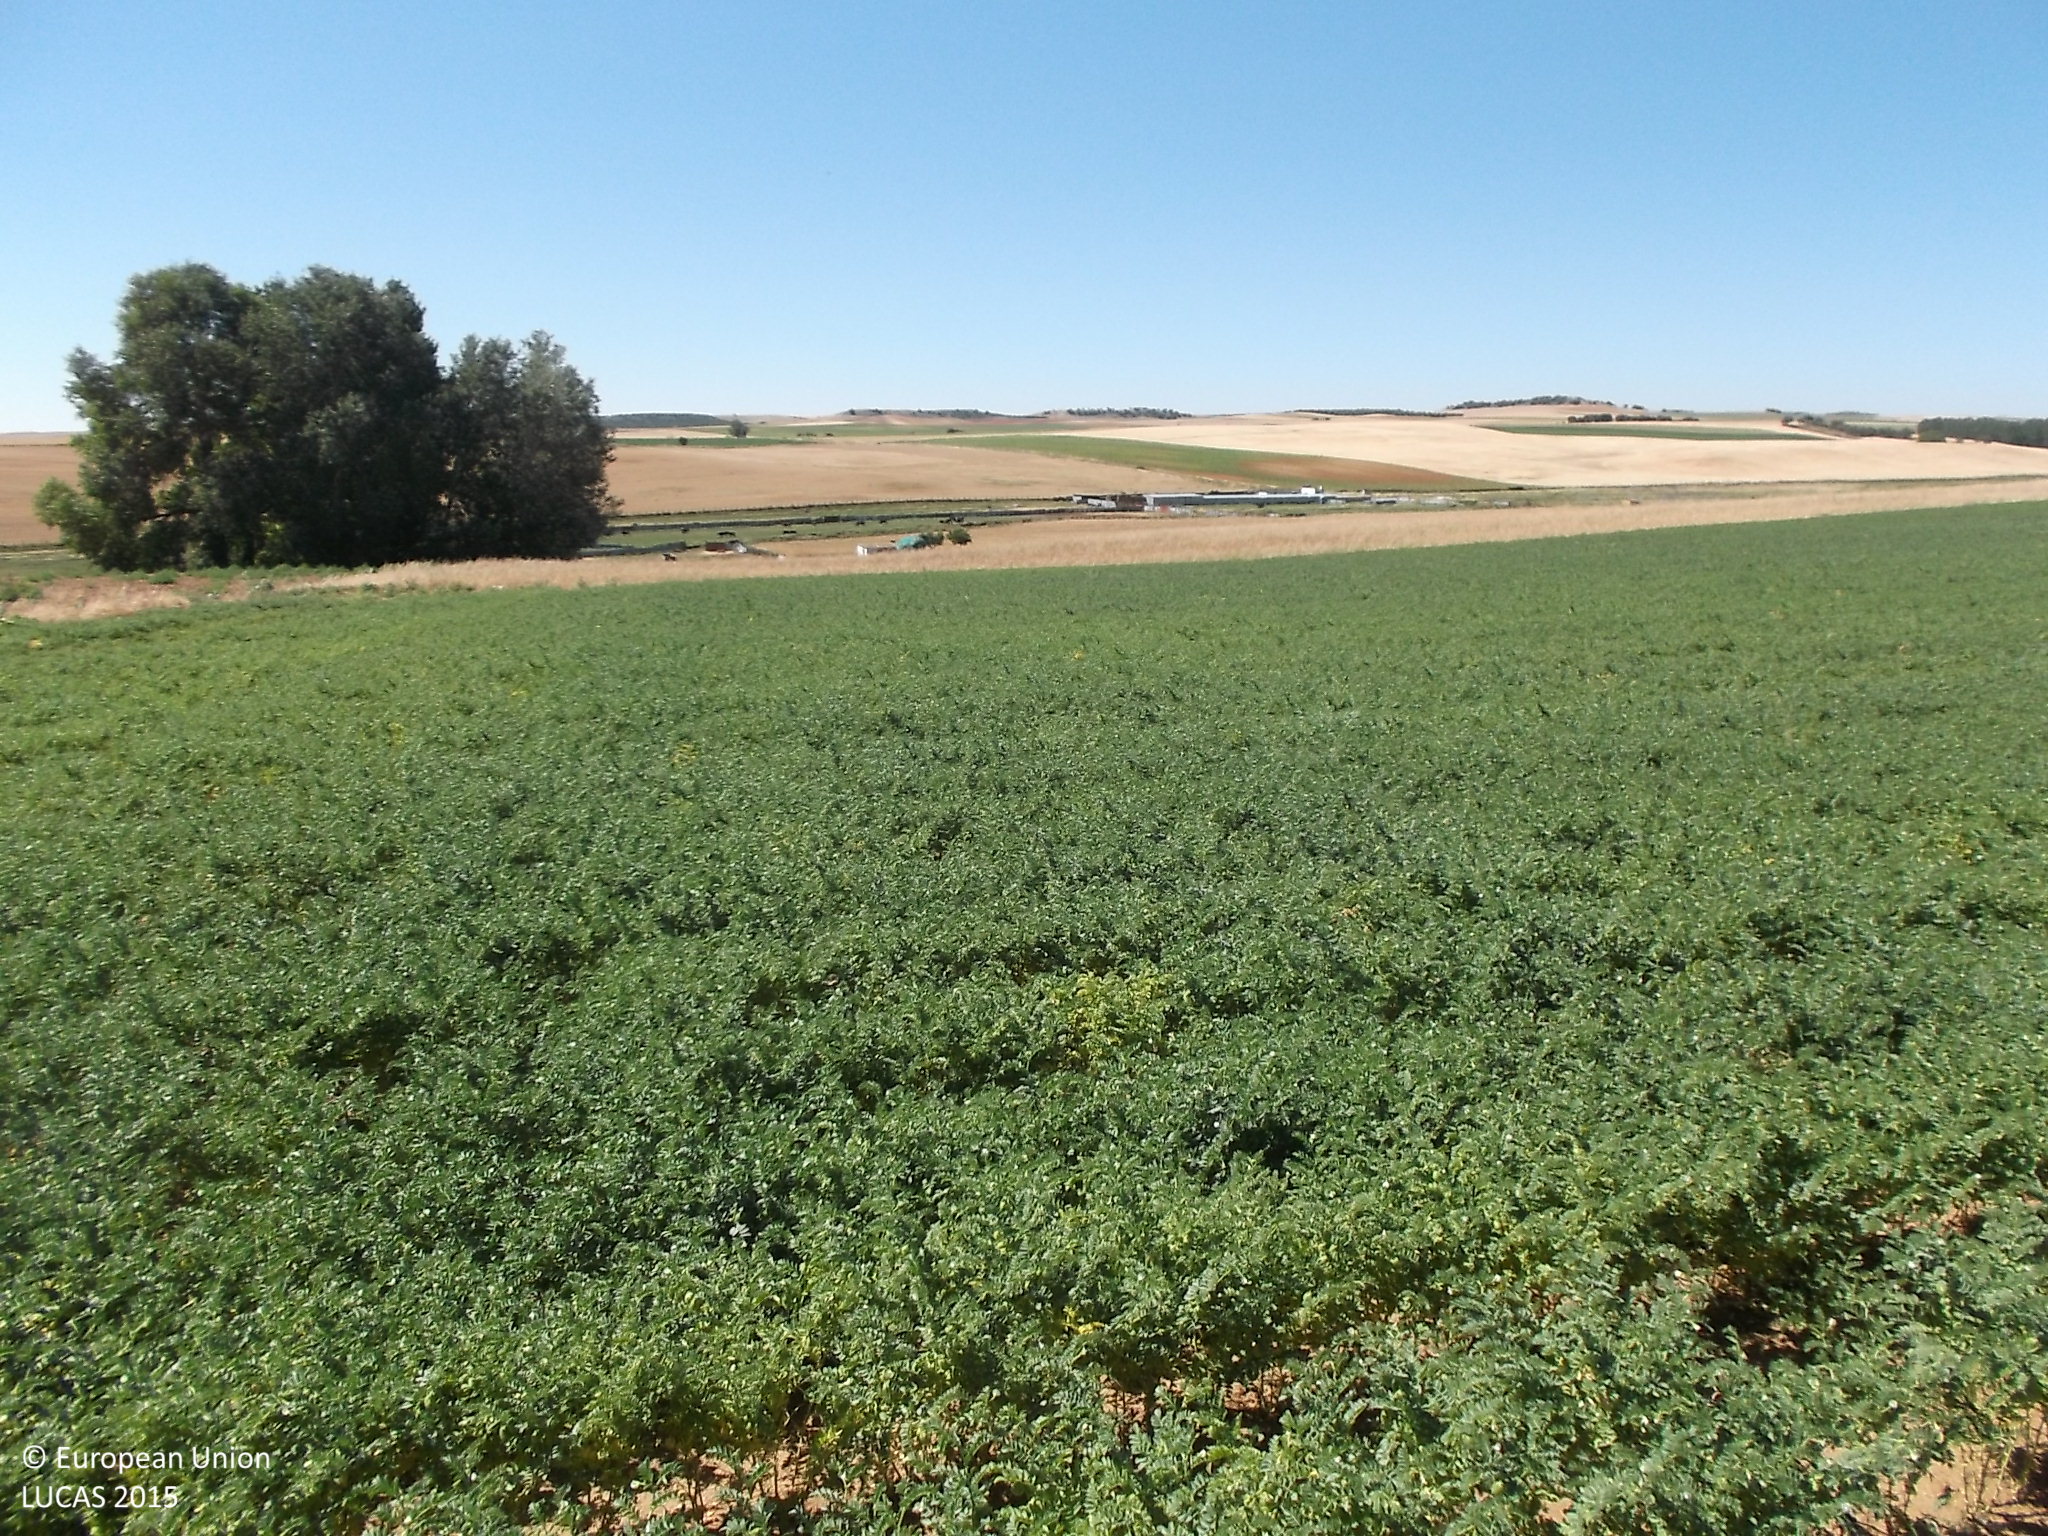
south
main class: Cropland
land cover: Dry pulses
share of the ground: > 75 %
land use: Agriculture (excluding fallow land and kitchen gardens)
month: June
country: ES
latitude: 41.2462
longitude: -5.4102
